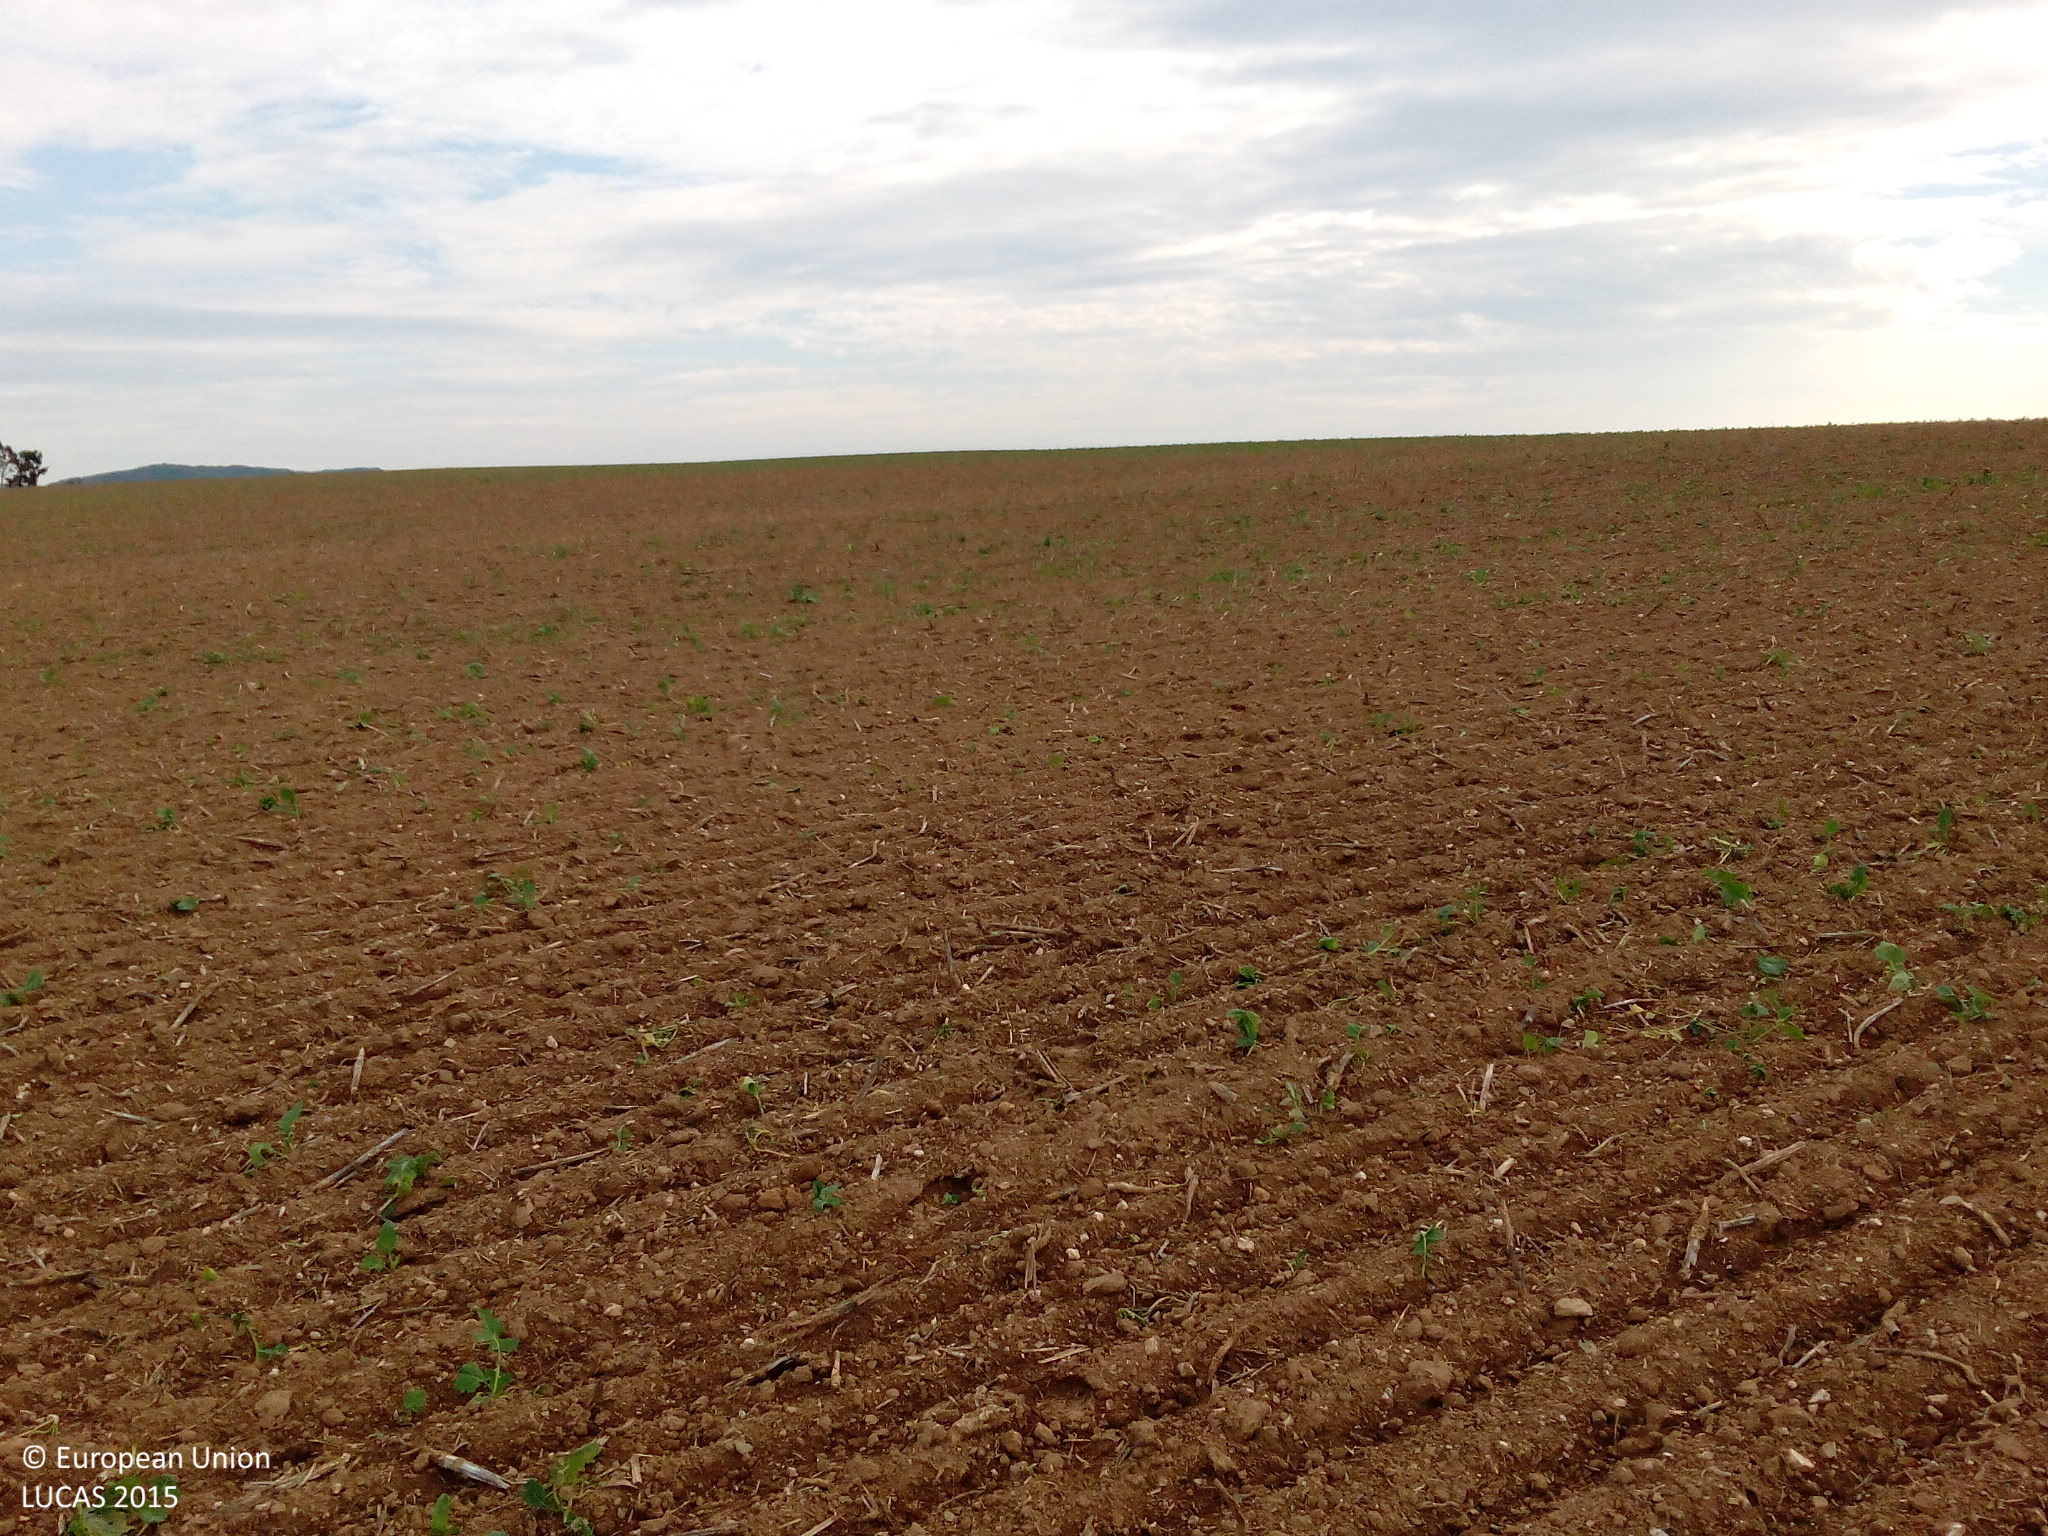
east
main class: Cropland
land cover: Rape and turnip rape
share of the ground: < 10 %
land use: Agriculture (excluding fallow land and kitchen gardens)
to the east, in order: Rape and turnip rape
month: September
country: DE
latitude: 51.4747
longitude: 10.9643
